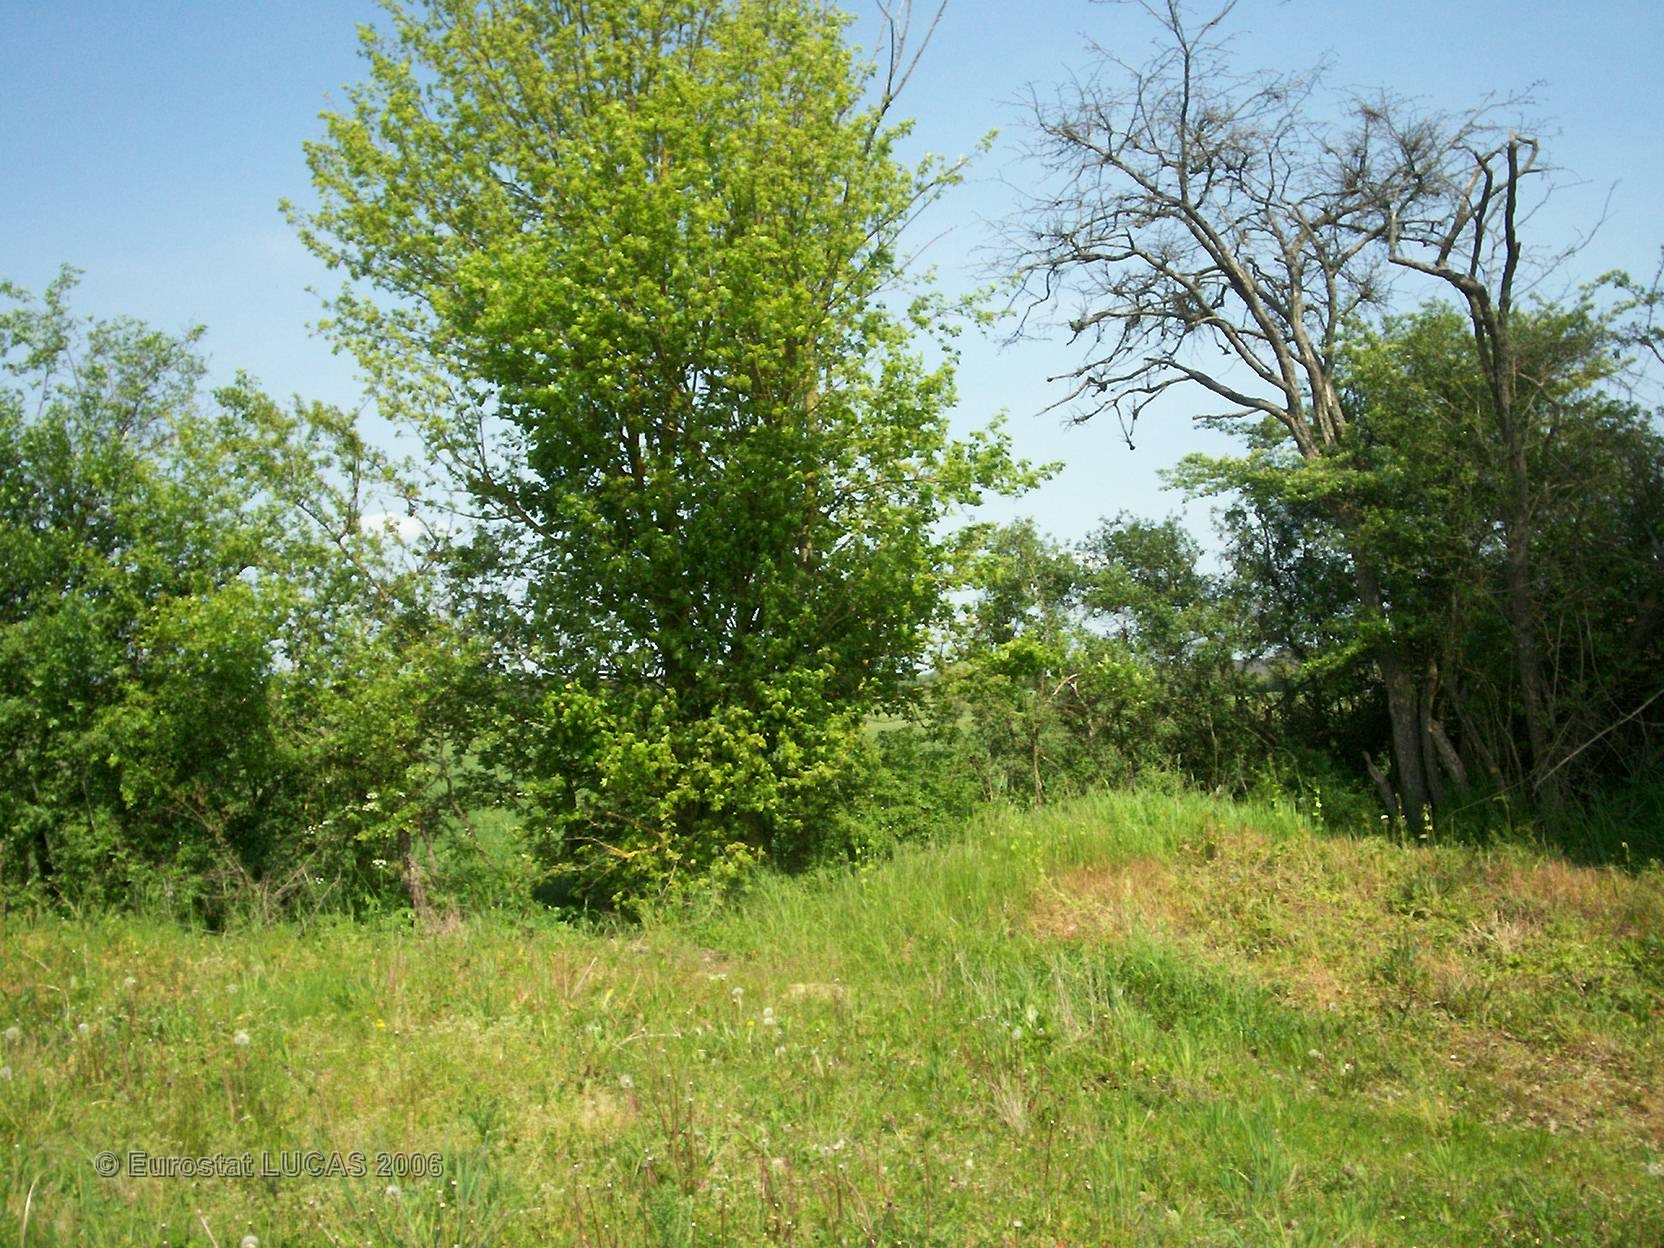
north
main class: Grassland
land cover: Grassland without tree/shrub cover
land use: Fallow land
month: May
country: FR
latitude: 46.3921
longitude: 0.4241
